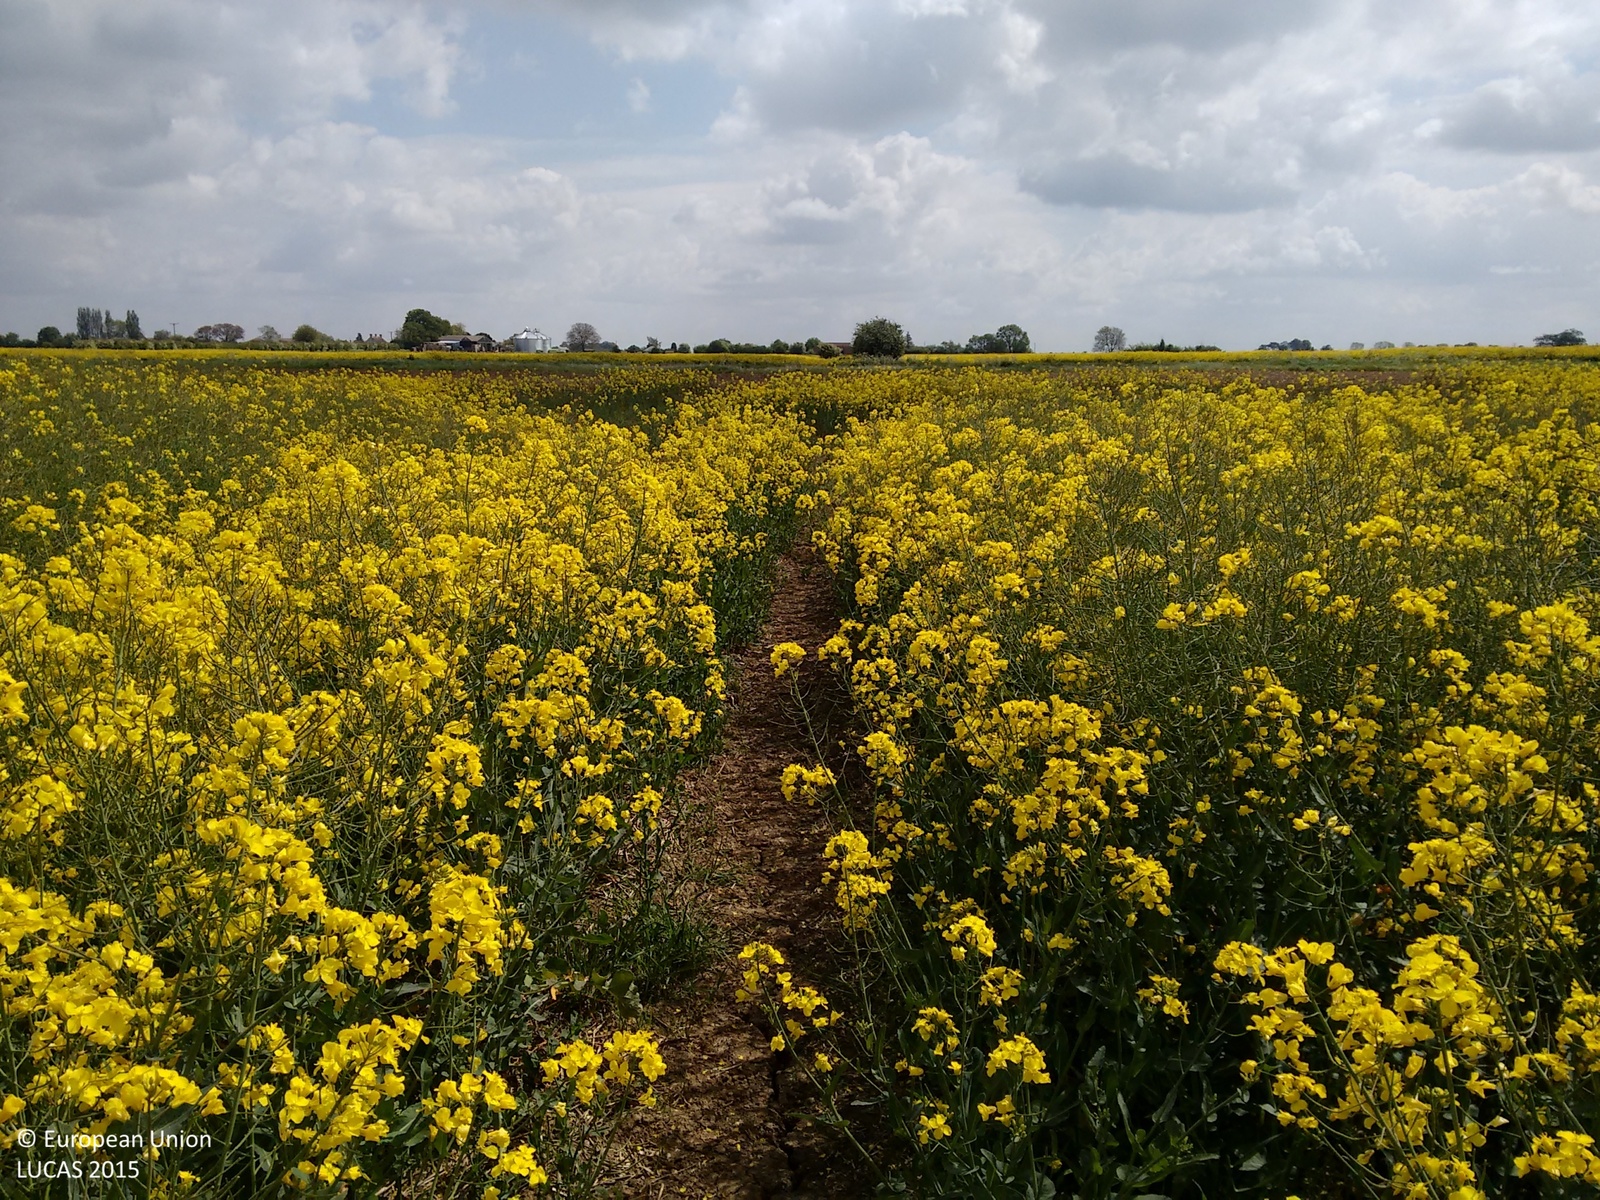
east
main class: Cropland
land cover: Rape and turnip rape
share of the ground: > 75 %
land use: Agriculture (excluding fallow land and kitchen gardens)
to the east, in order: Rape and turnip rape; Other bare soil; Grassland without tree/shrub cover; Ditches and canals; Grass margins; Rape and turnip rape
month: May
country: GB
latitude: 52.7260
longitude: -0.0872
